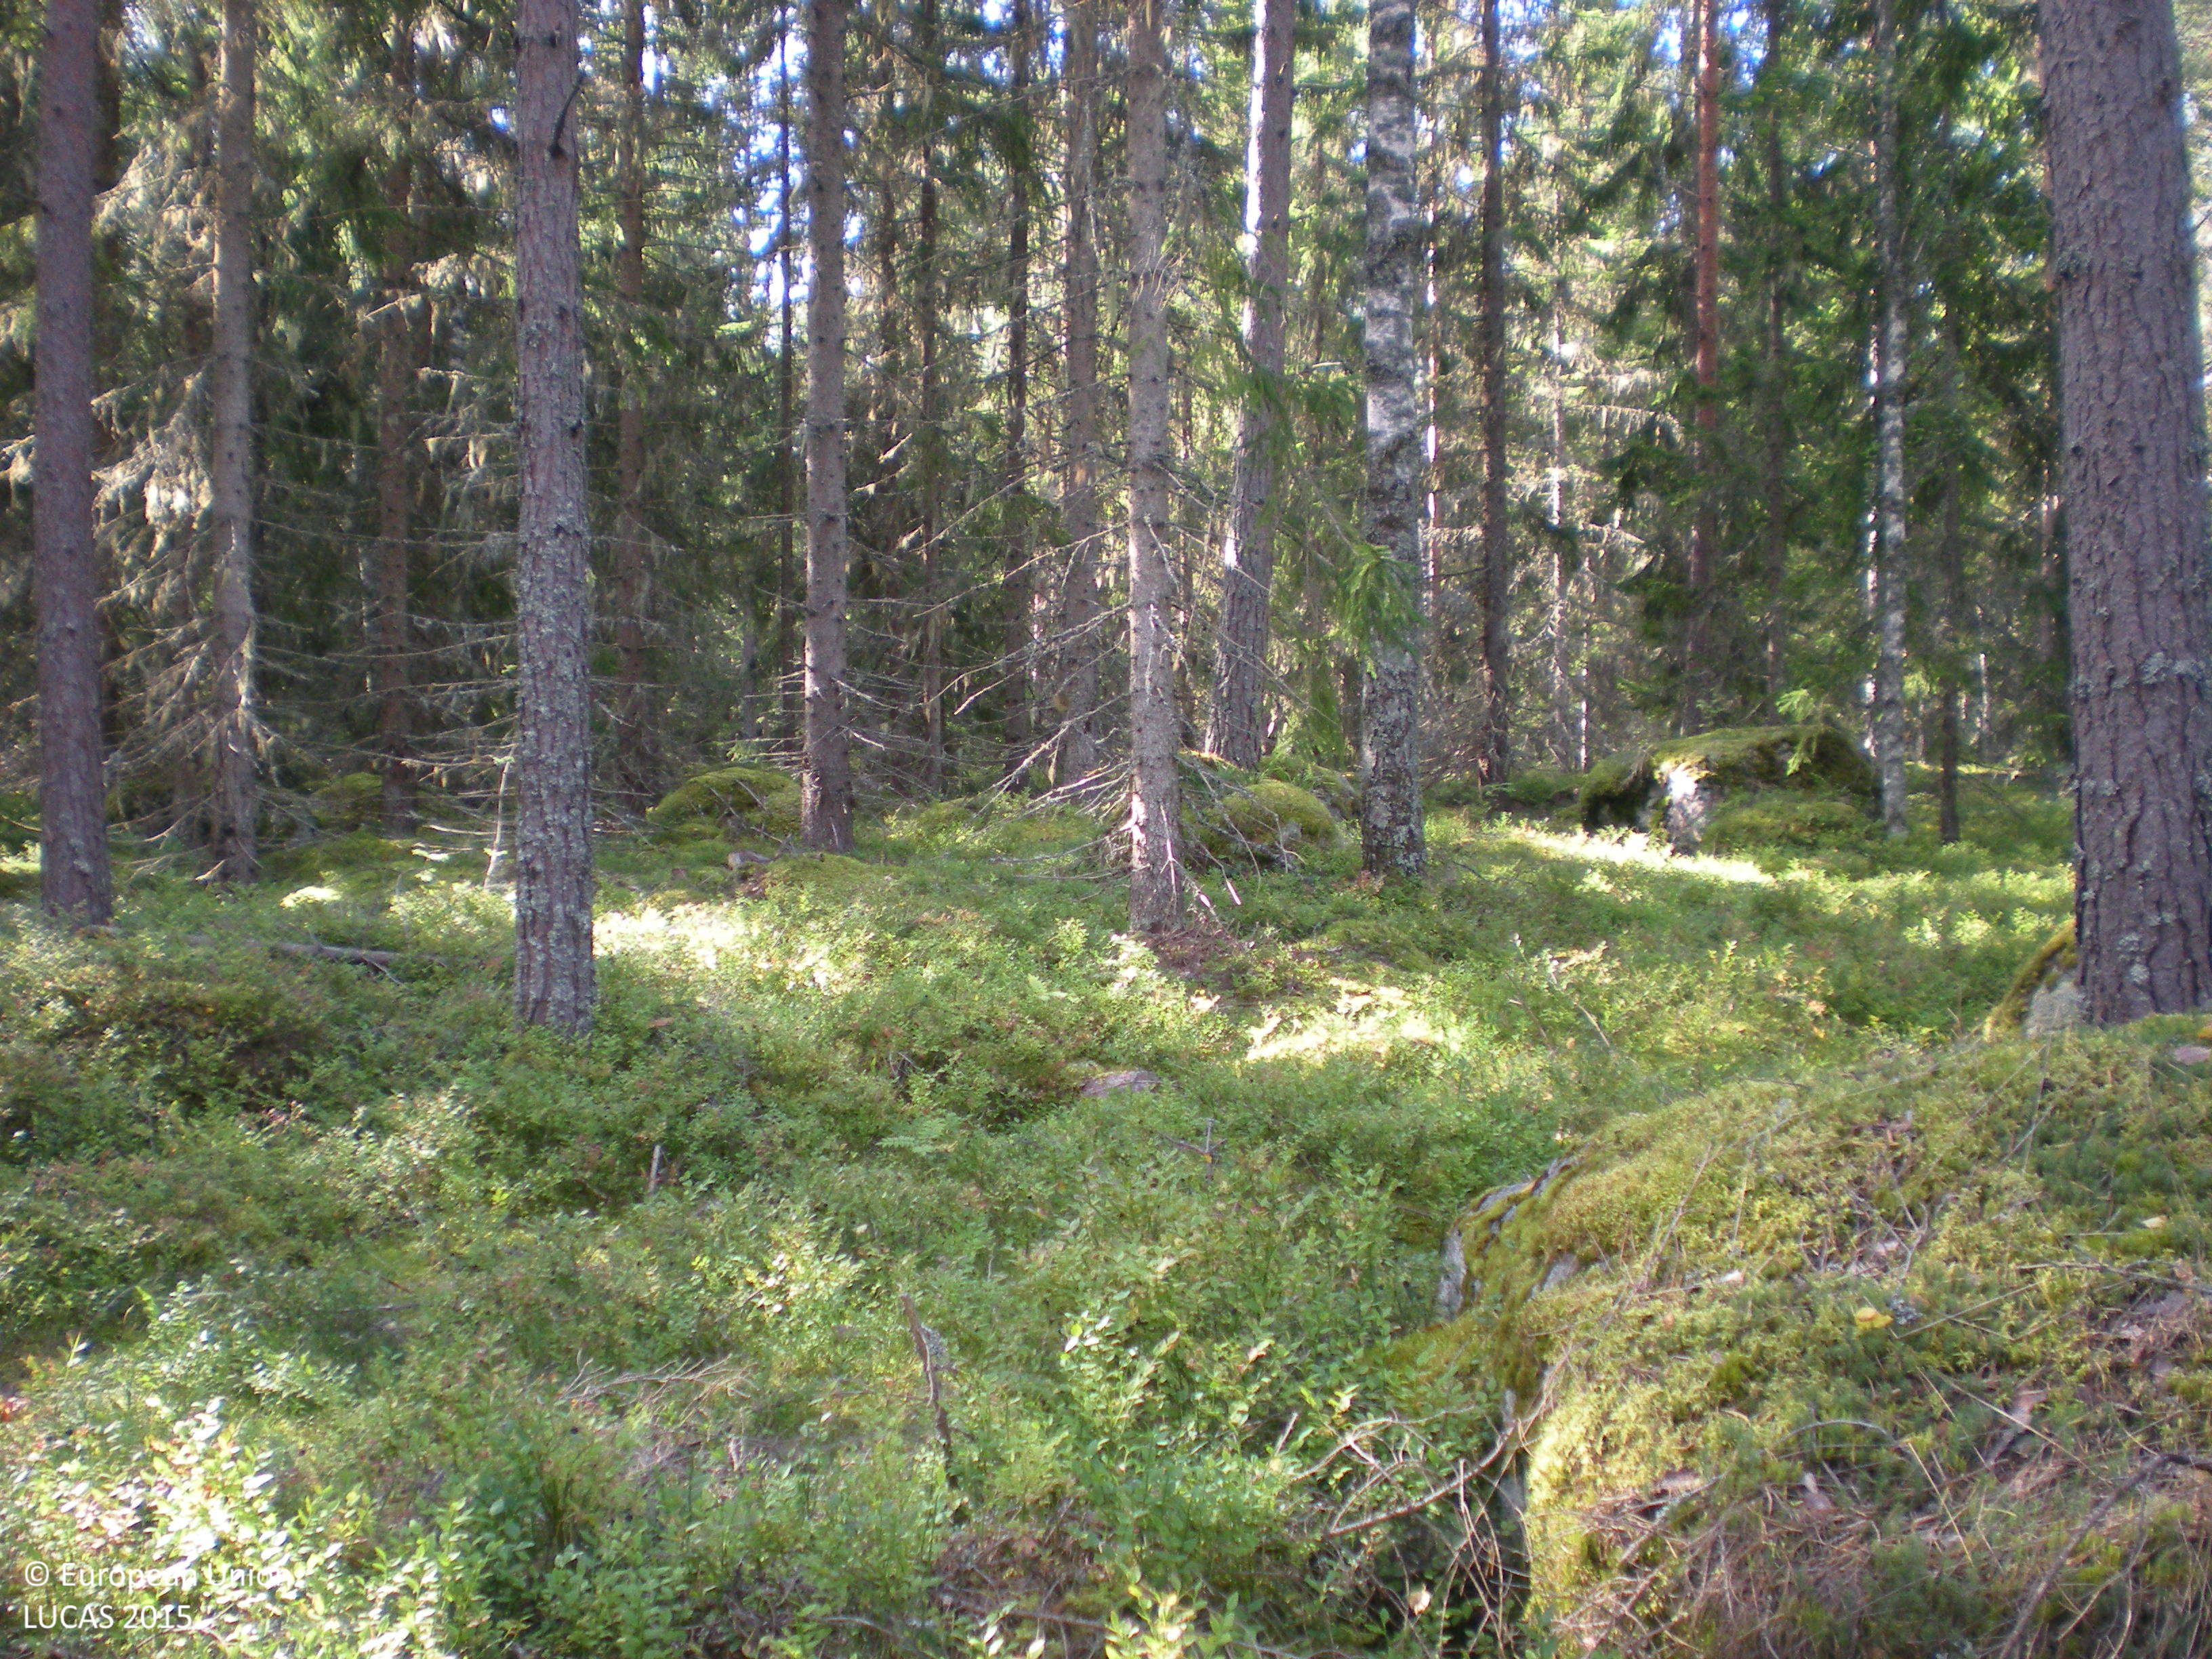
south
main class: Woodland
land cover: Other coniferous woodland
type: boreal forest
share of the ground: 50 - 75 %
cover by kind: coniferous forest trees 70 %, shrubs 20 %, broadleaved forest trees 5 %, lichens and mosses 5 %
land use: Forestry
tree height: > 5 m
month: August
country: SE
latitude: 60.4379
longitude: 17.0584
